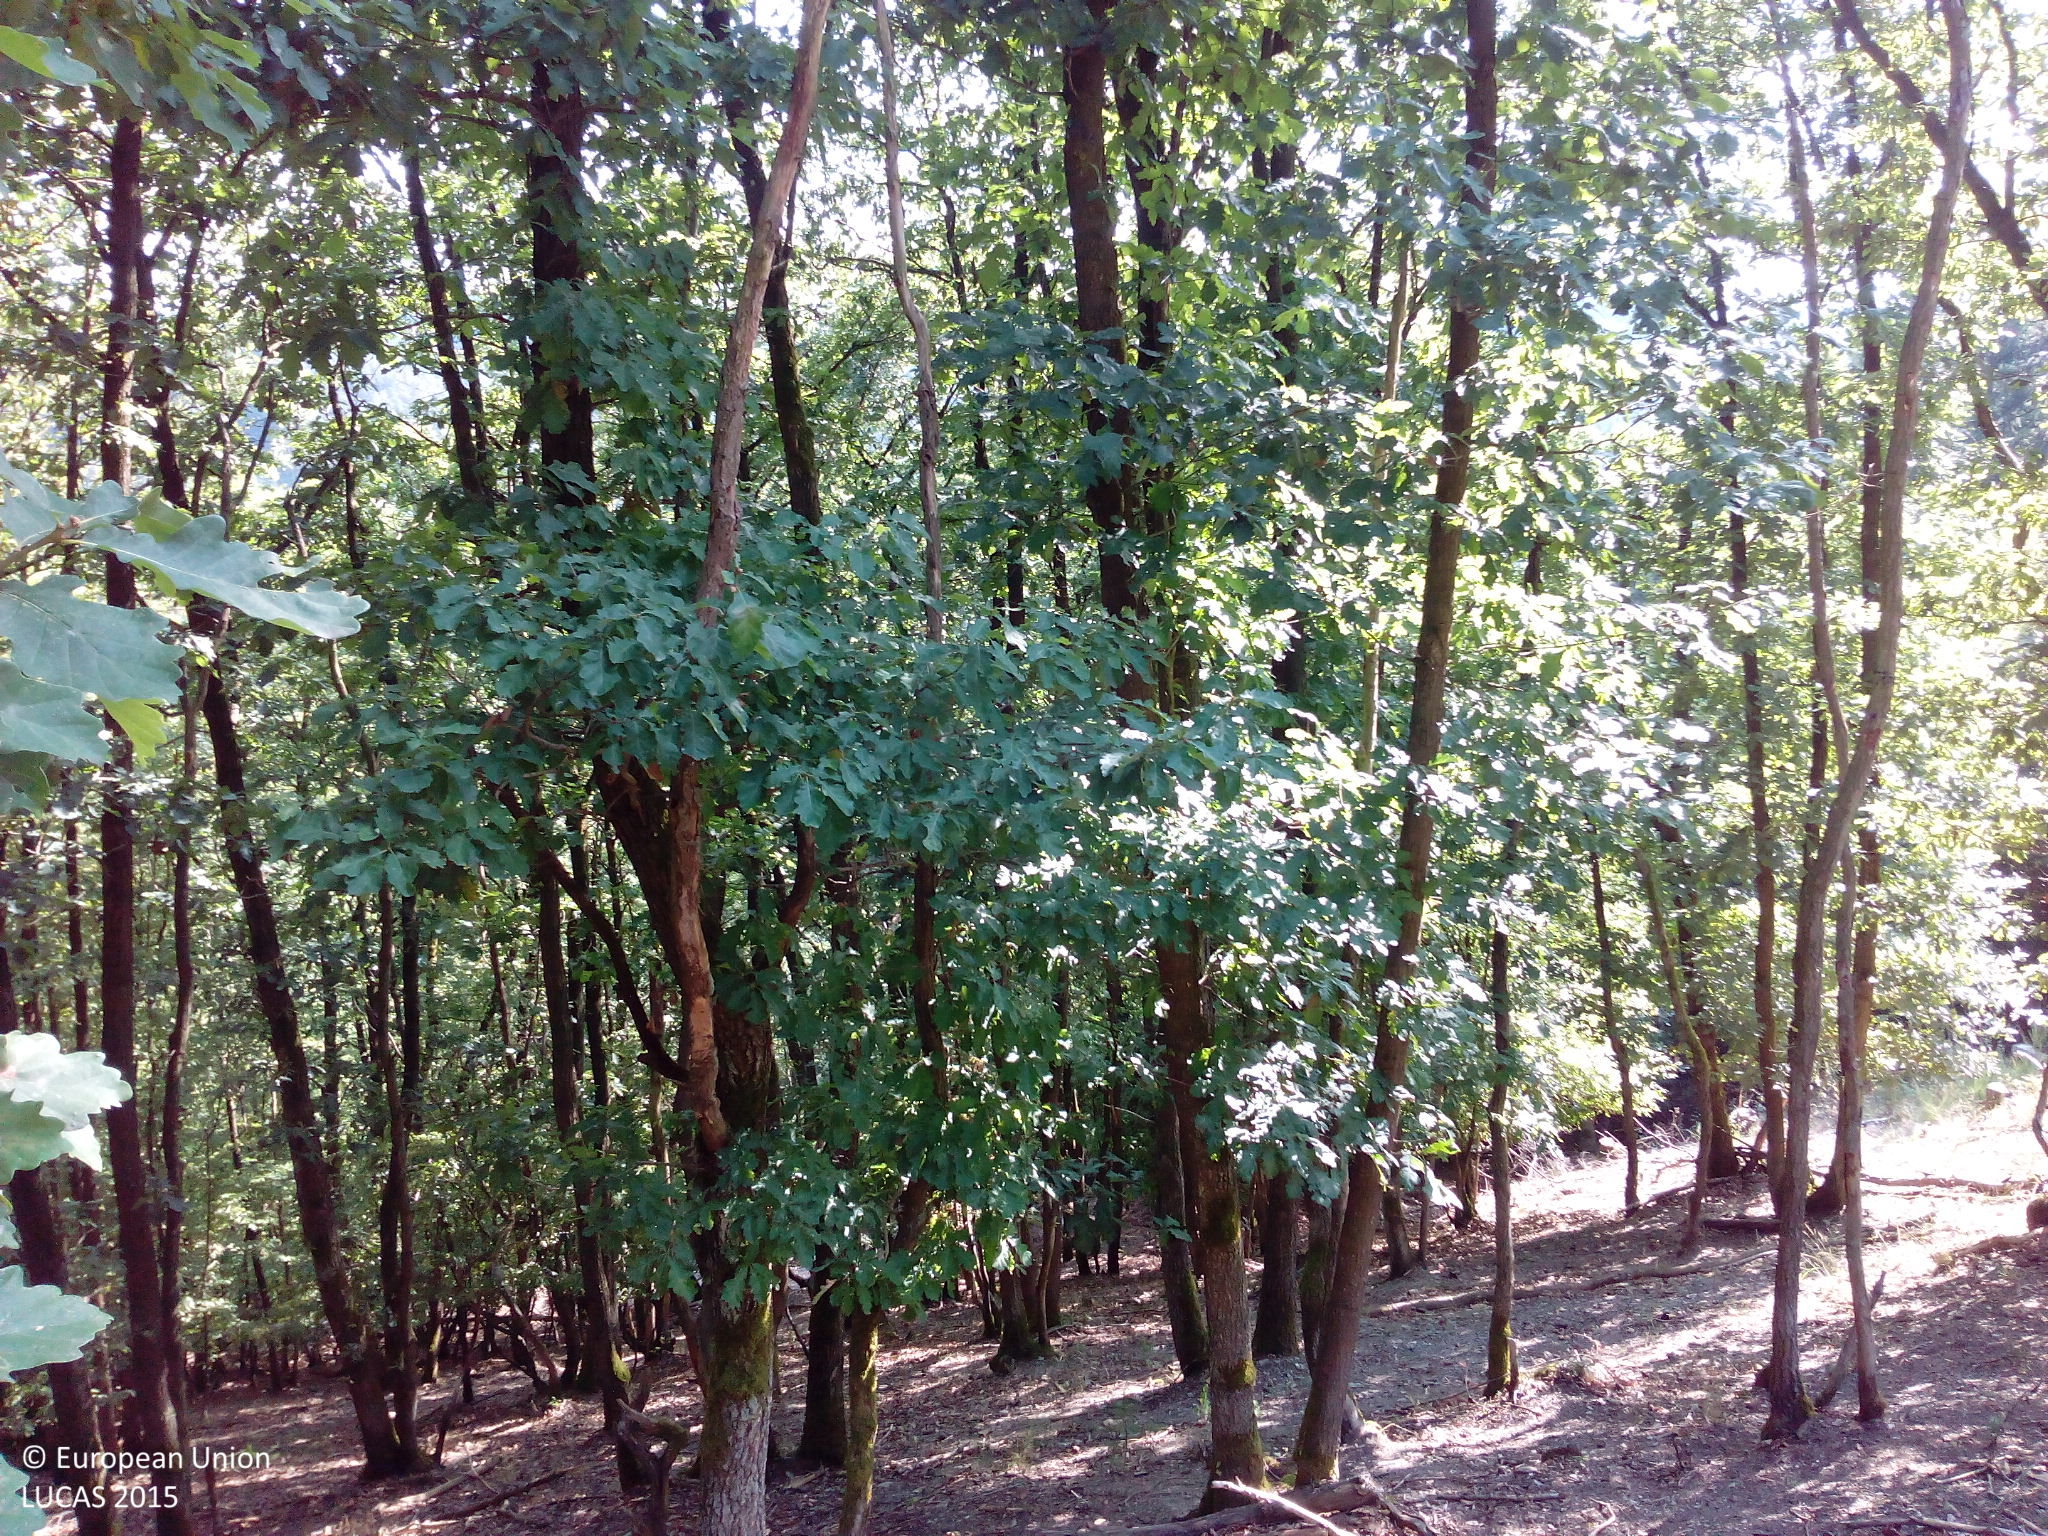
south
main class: Woodland
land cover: Broadleaved woodland
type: mesophytic deciduous forest
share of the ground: > 75 %
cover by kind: broadleaved forest trees 90 %, herbaceous plants 10 %
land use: Forestry
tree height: > 5 m
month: August
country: DE
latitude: 50.1388
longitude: 7.4958
